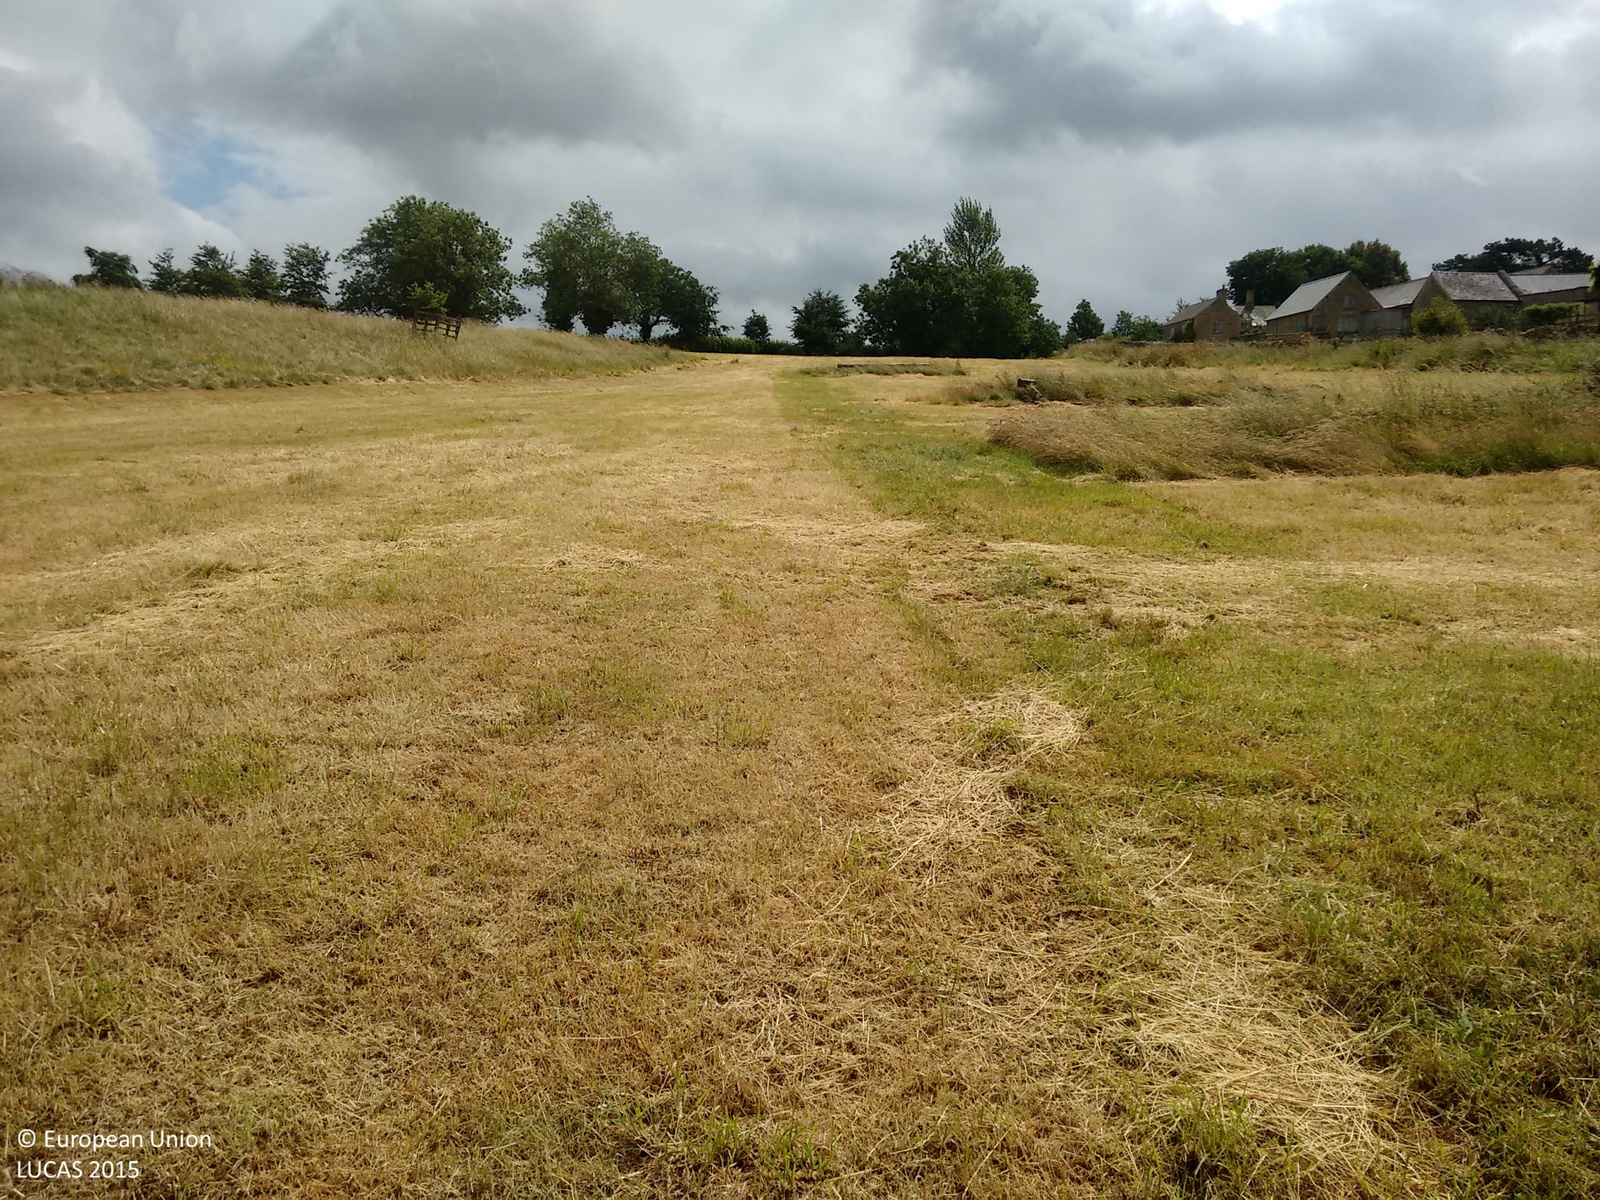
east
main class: Grassland
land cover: Grassland without tree/shrub cover
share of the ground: > 75 %
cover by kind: herbaceous plants 100 %
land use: Residential
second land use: Agriculture (excluding fallow land and kitchen gardens)
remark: Harvested field
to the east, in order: Grassland without tree/shrub cover; Managed hedges; Tracks; Managed hedges; Grassland without tree/shrub cover; Tracks; Grassland without tree/shrub cover
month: July
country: GB
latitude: 51.8997
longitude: -1.5771
